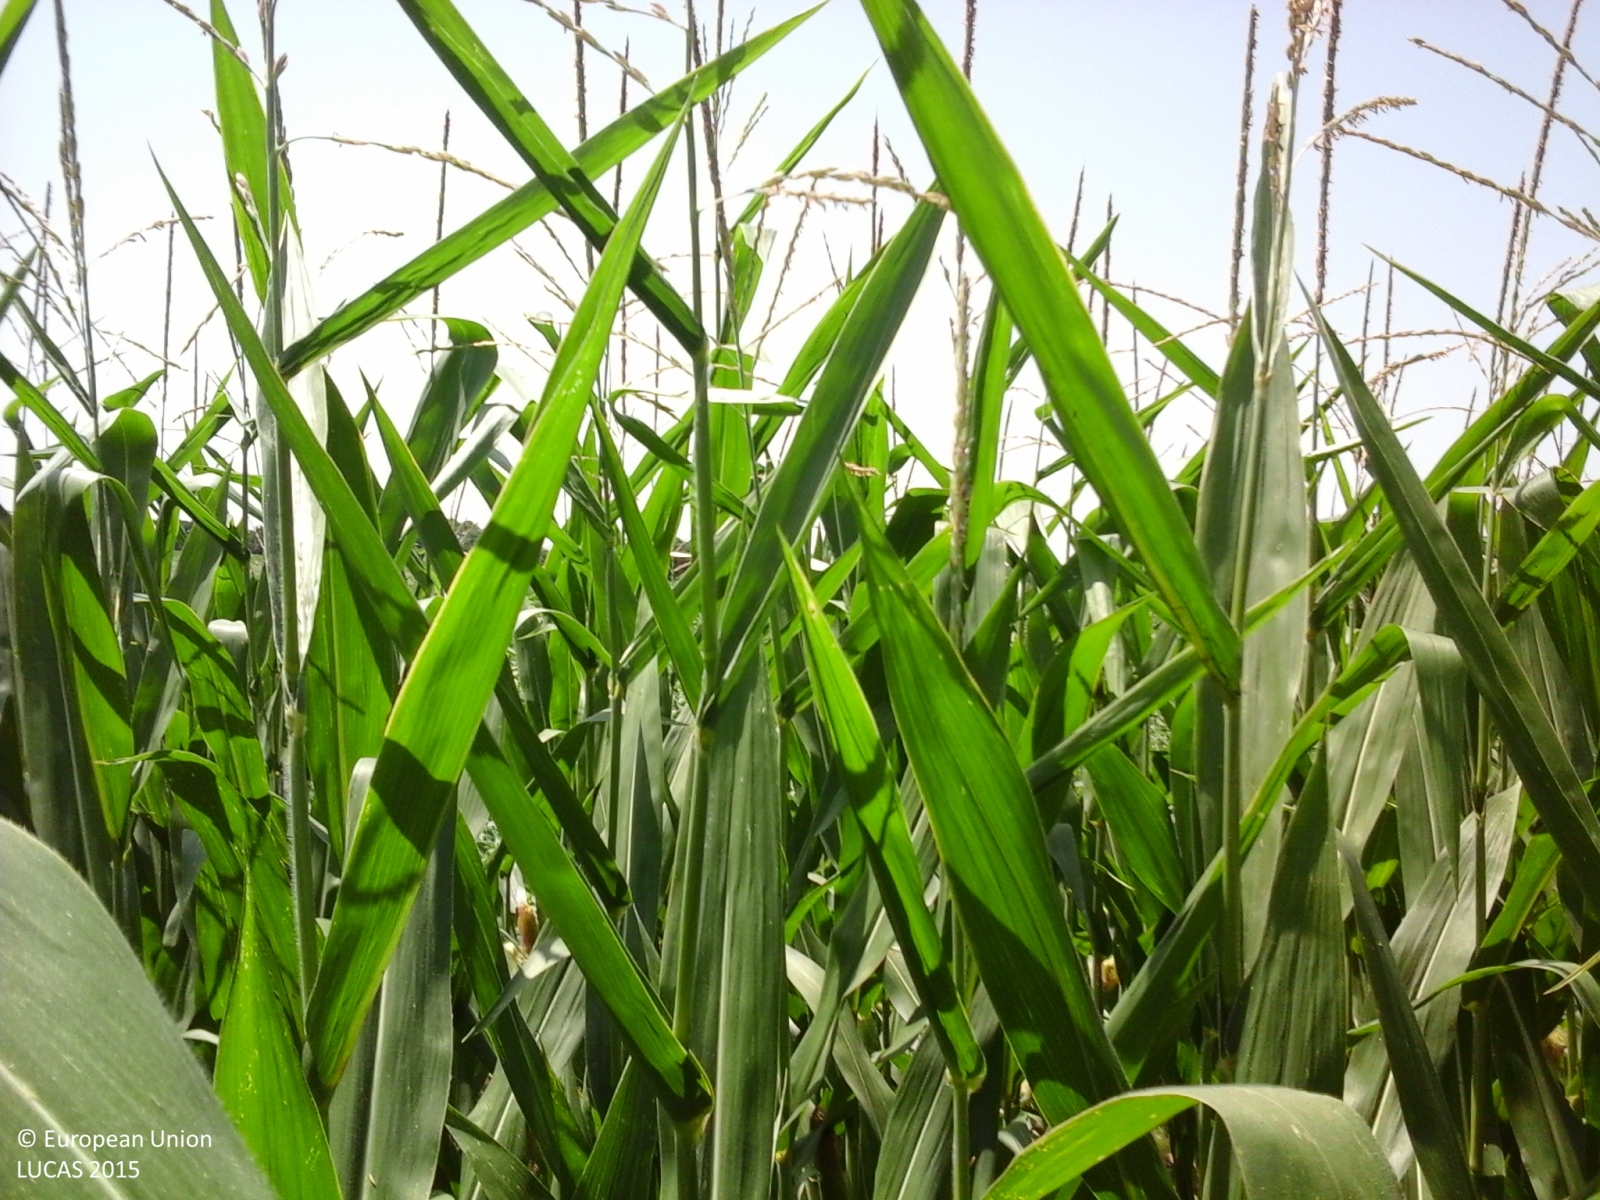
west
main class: Cropland
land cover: Maize
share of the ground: > 75 %
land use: Agriculture (excluding fallow land and kitchen gardens)
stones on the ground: < 10 %
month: July
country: IT
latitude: 43.3703
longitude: 13.5084
